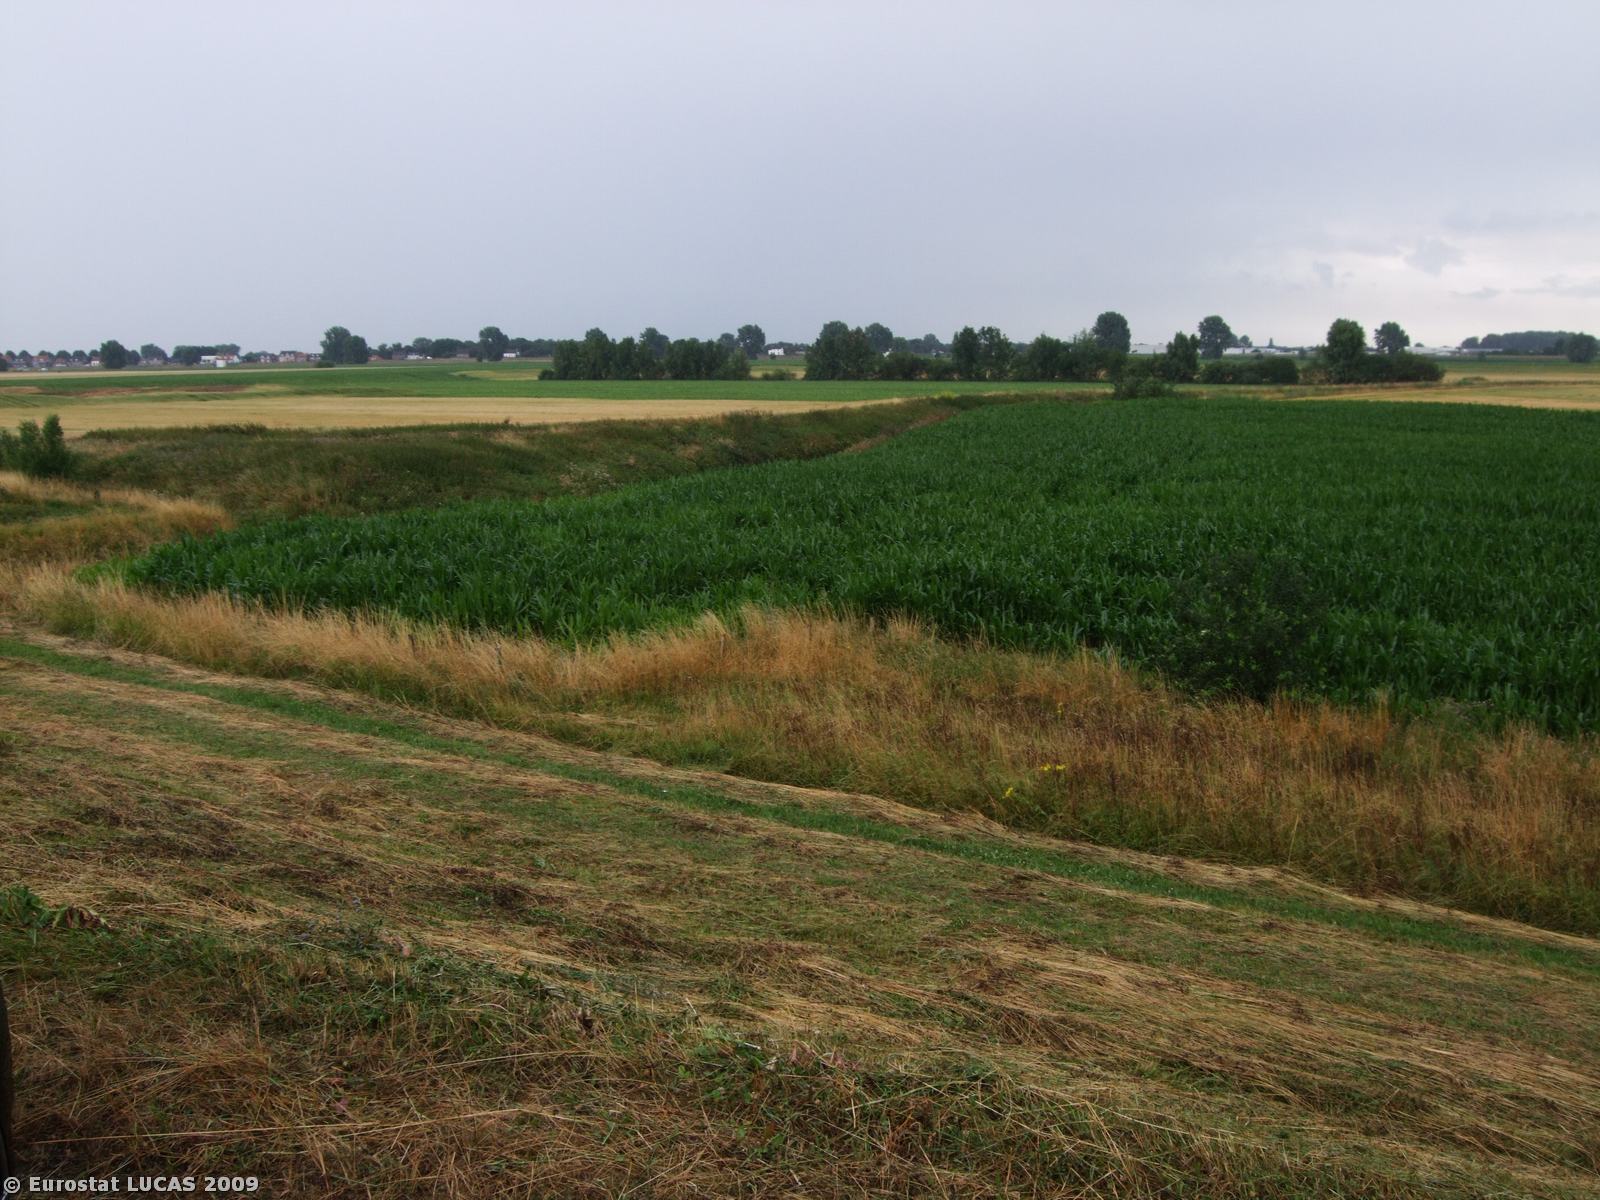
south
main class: Cropland
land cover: Maize
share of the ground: > 75 %
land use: Agriculture (excluding fallow land and kitchen gardens)
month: July
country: NL
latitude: 51.8214
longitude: 5.4281
